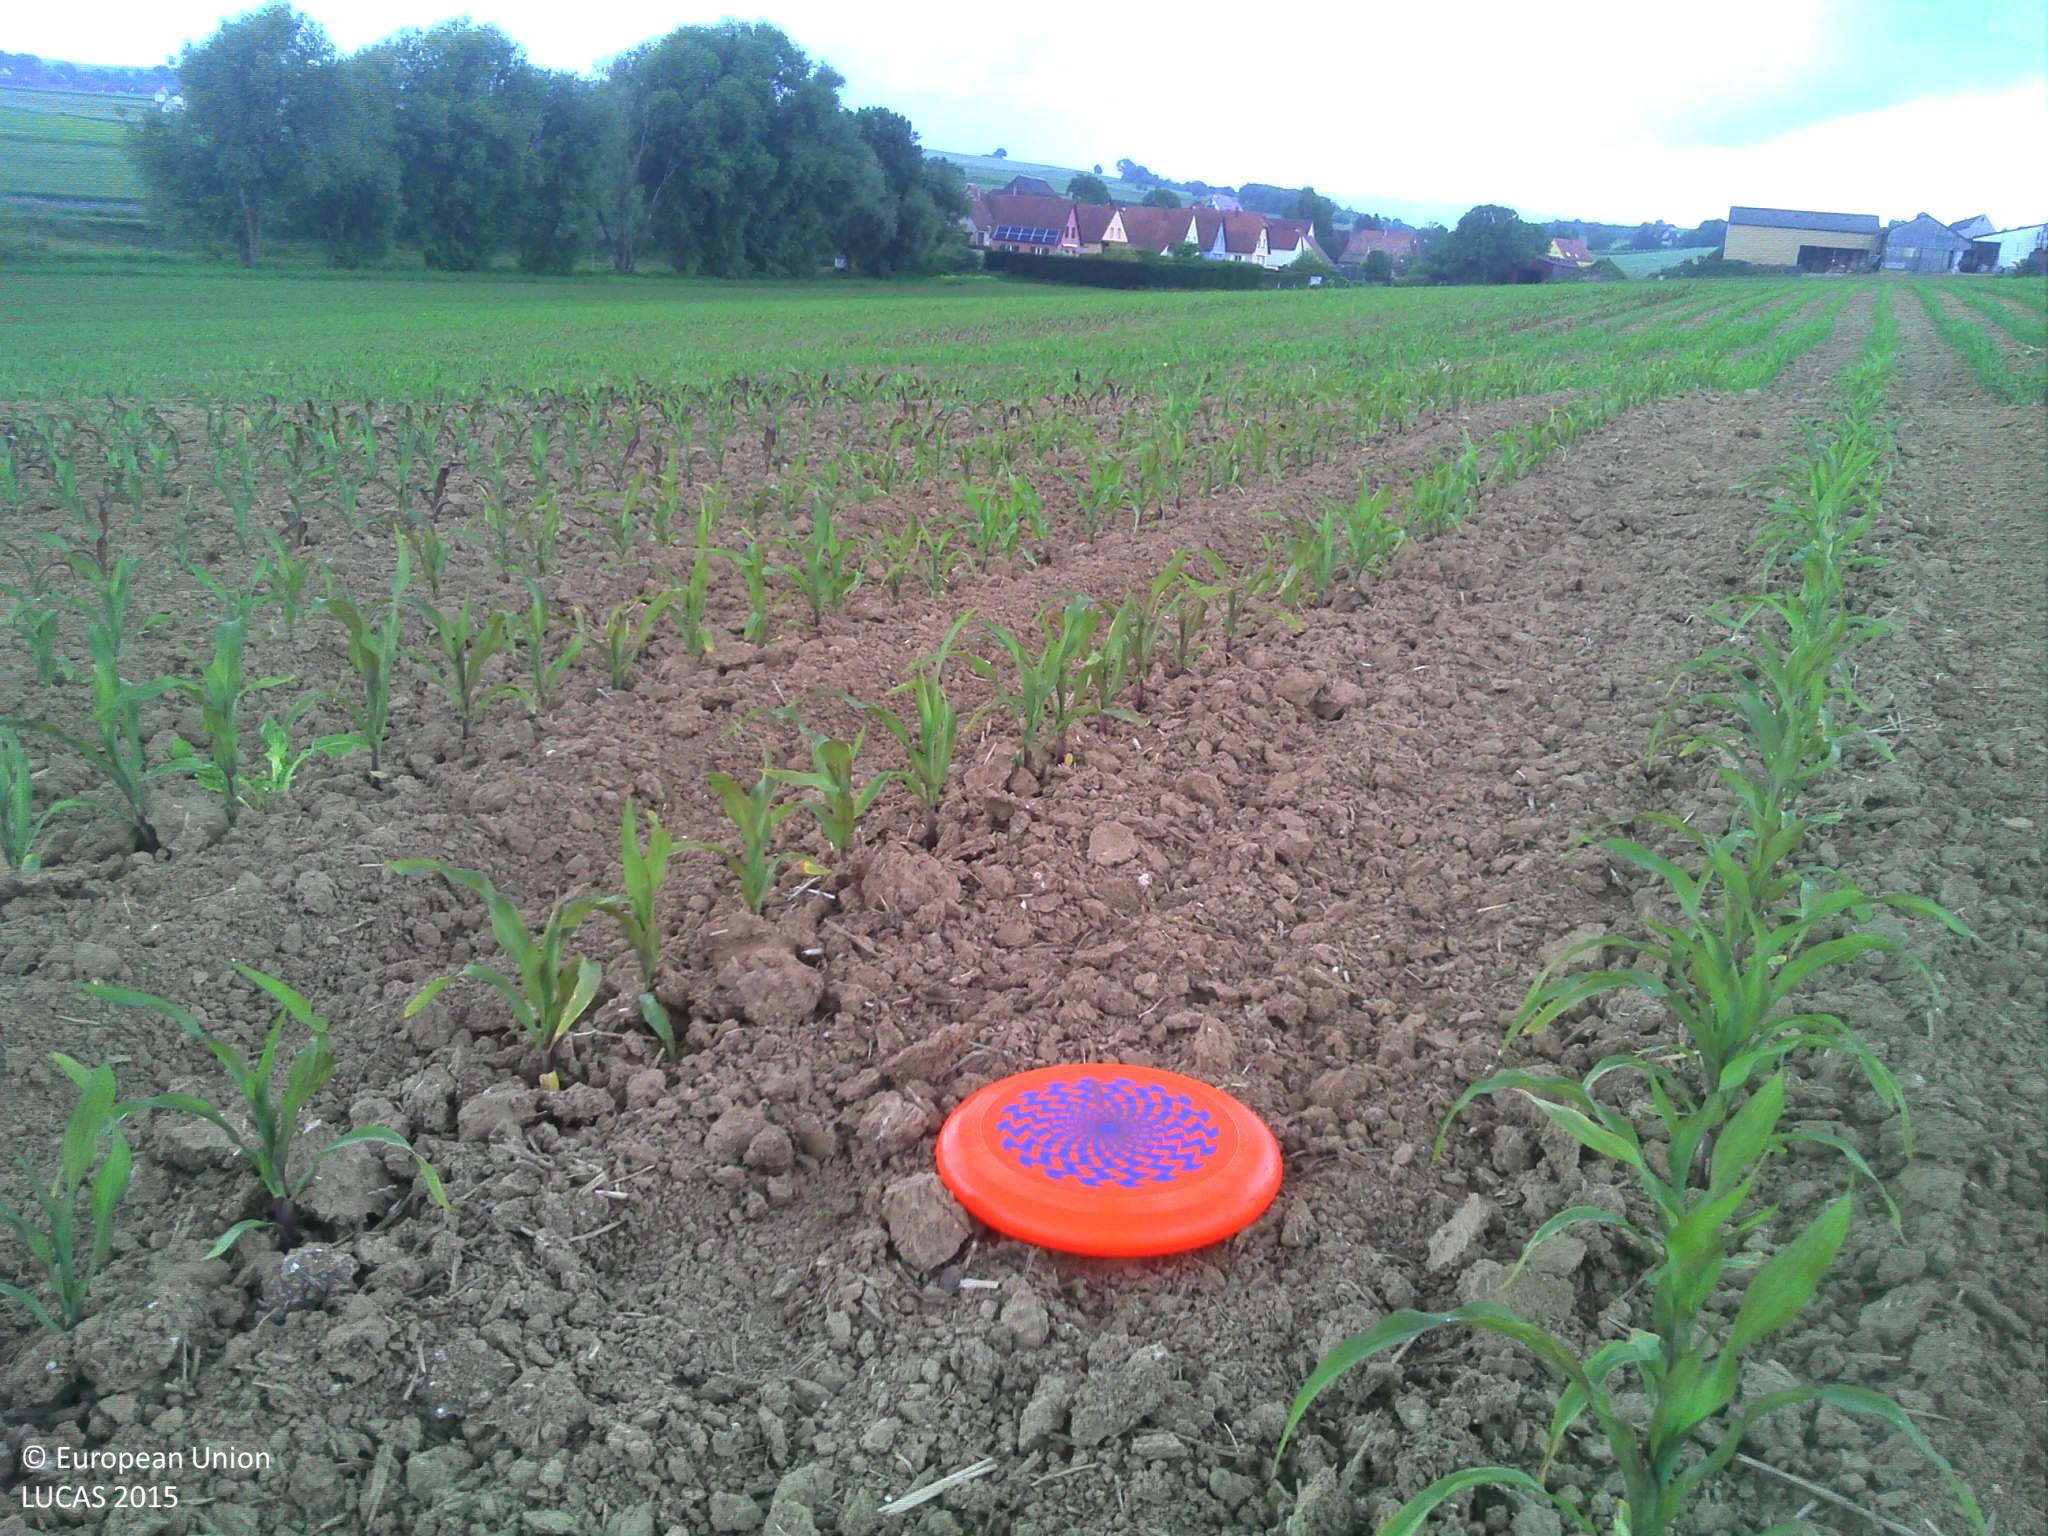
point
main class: Cropland
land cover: Maize
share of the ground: 10 - 25 %
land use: Agriculture (excluding fallow land and kitchen gardens)
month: May
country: FR
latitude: 48.6816
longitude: 7.5152
